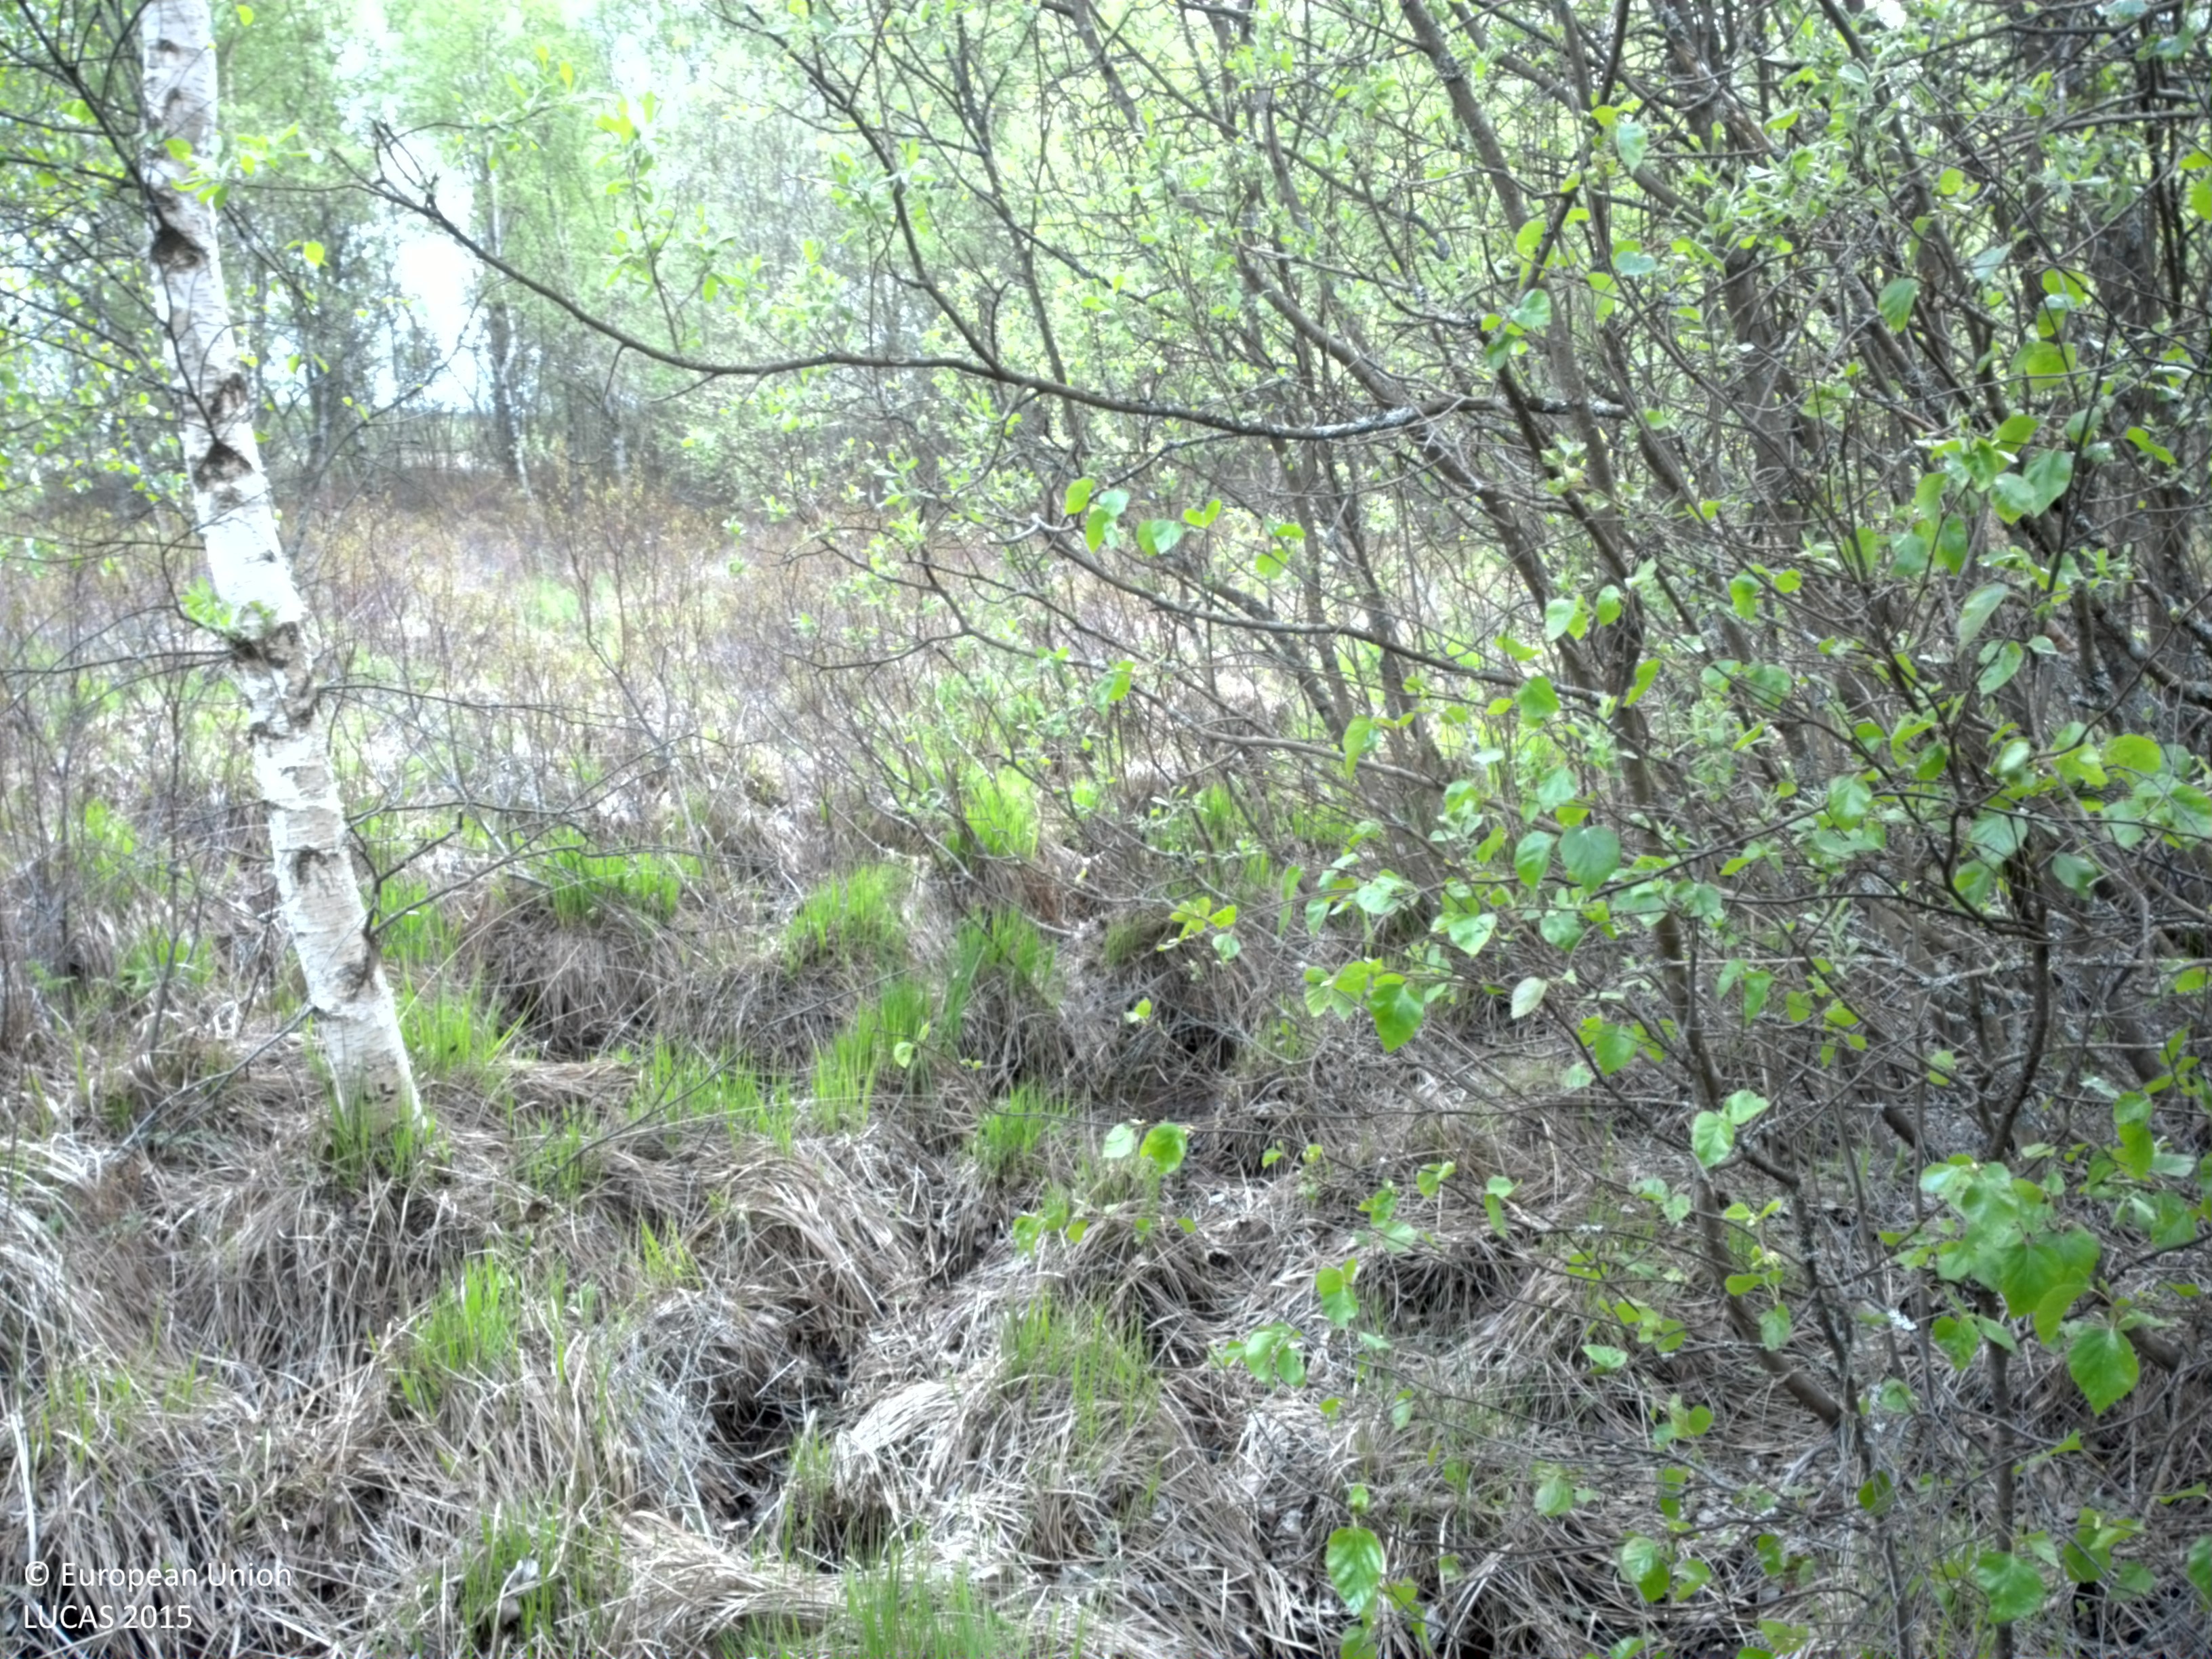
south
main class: Woodland
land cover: Broadleaved woodland
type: mire and swamp forests
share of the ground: > 75 %
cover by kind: broadleaved forest trees 75 %, herbaceous plants 25 %
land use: Semi-natural and natural areas not in use
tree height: > 5 m
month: May
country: SE
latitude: 56.6769
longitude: 15.2046
